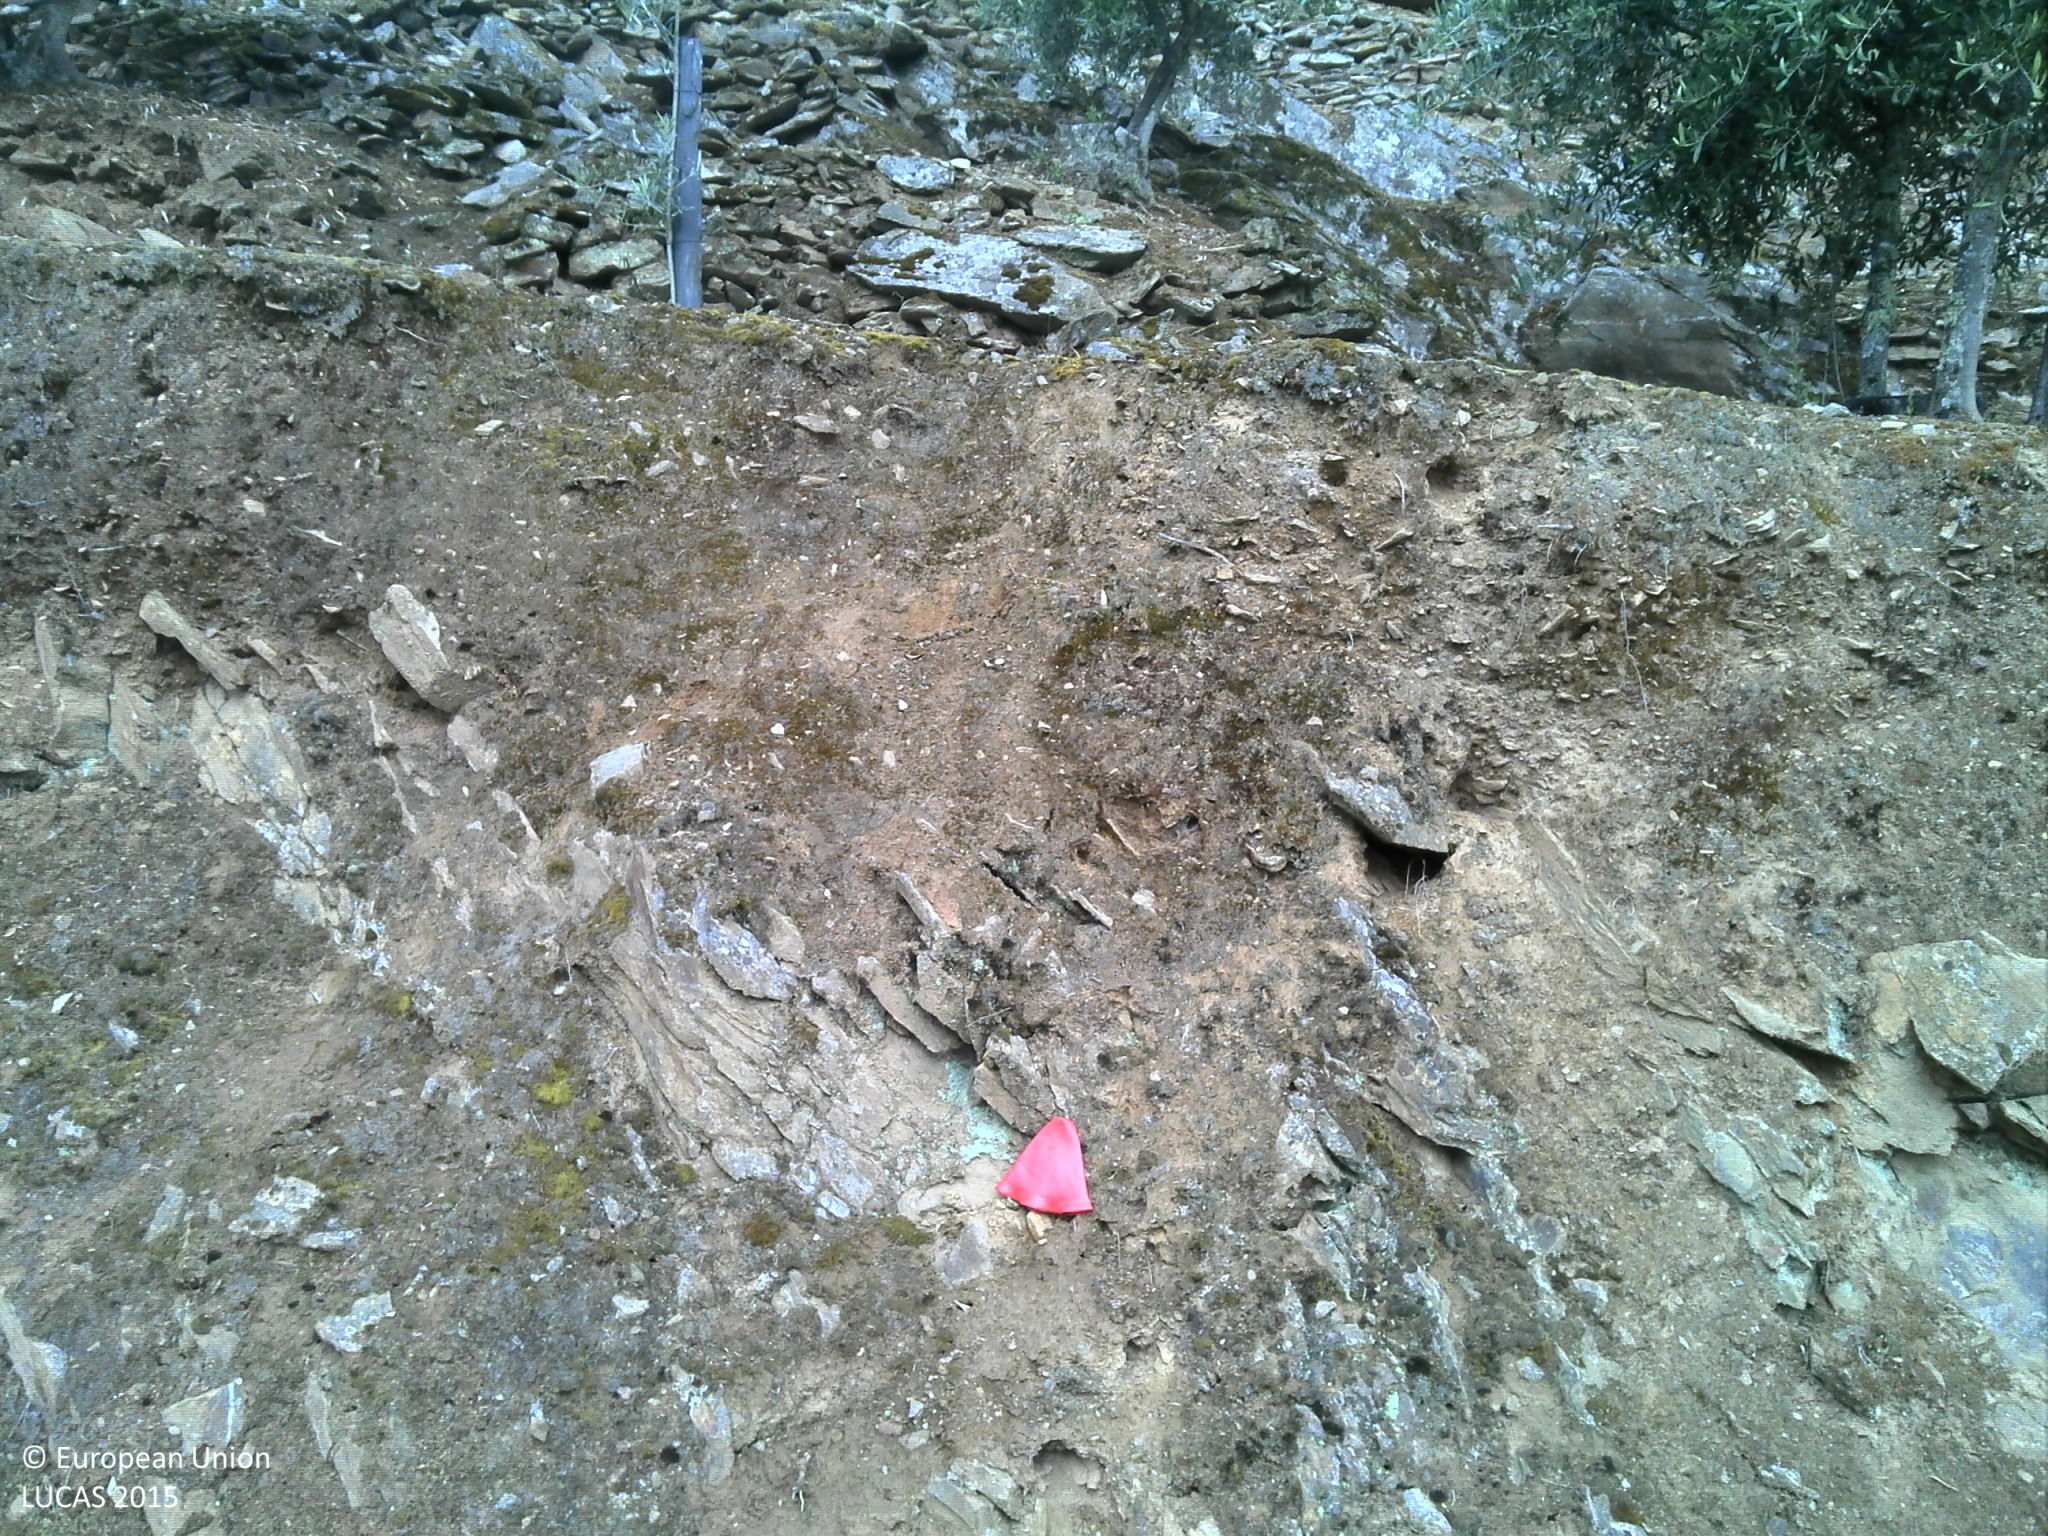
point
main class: Cropland
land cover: Olive groves
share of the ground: < 10 %
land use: Agriculture (excluding fallow land and kitchen gardens)
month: June
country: PT
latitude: 41.1220
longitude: -7.5719
